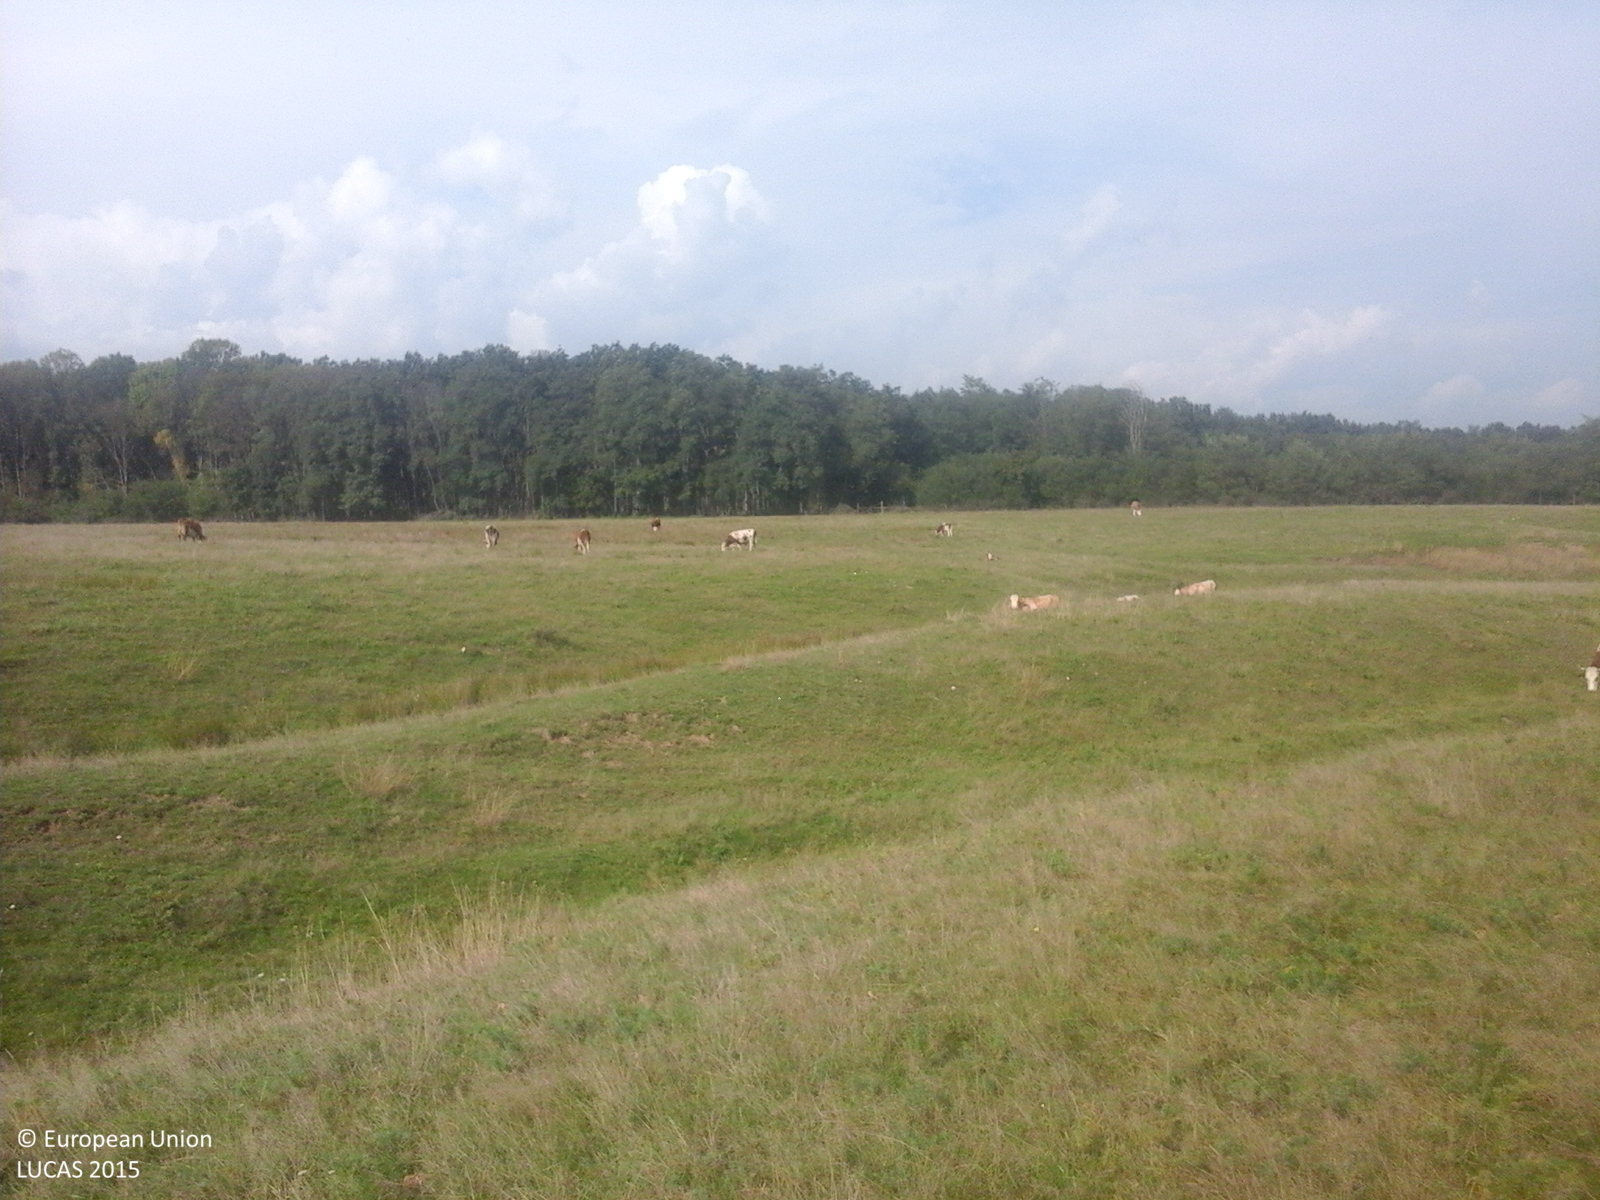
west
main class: Grassland
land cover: Grassland without tree/shrub cover
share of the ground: > 75 %
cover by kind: herbaceous plants 100 %
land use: Agriculture (excluding fallow land and kitchen gardens)
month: October
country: RO
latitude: 46.3091
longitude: 23.6646
